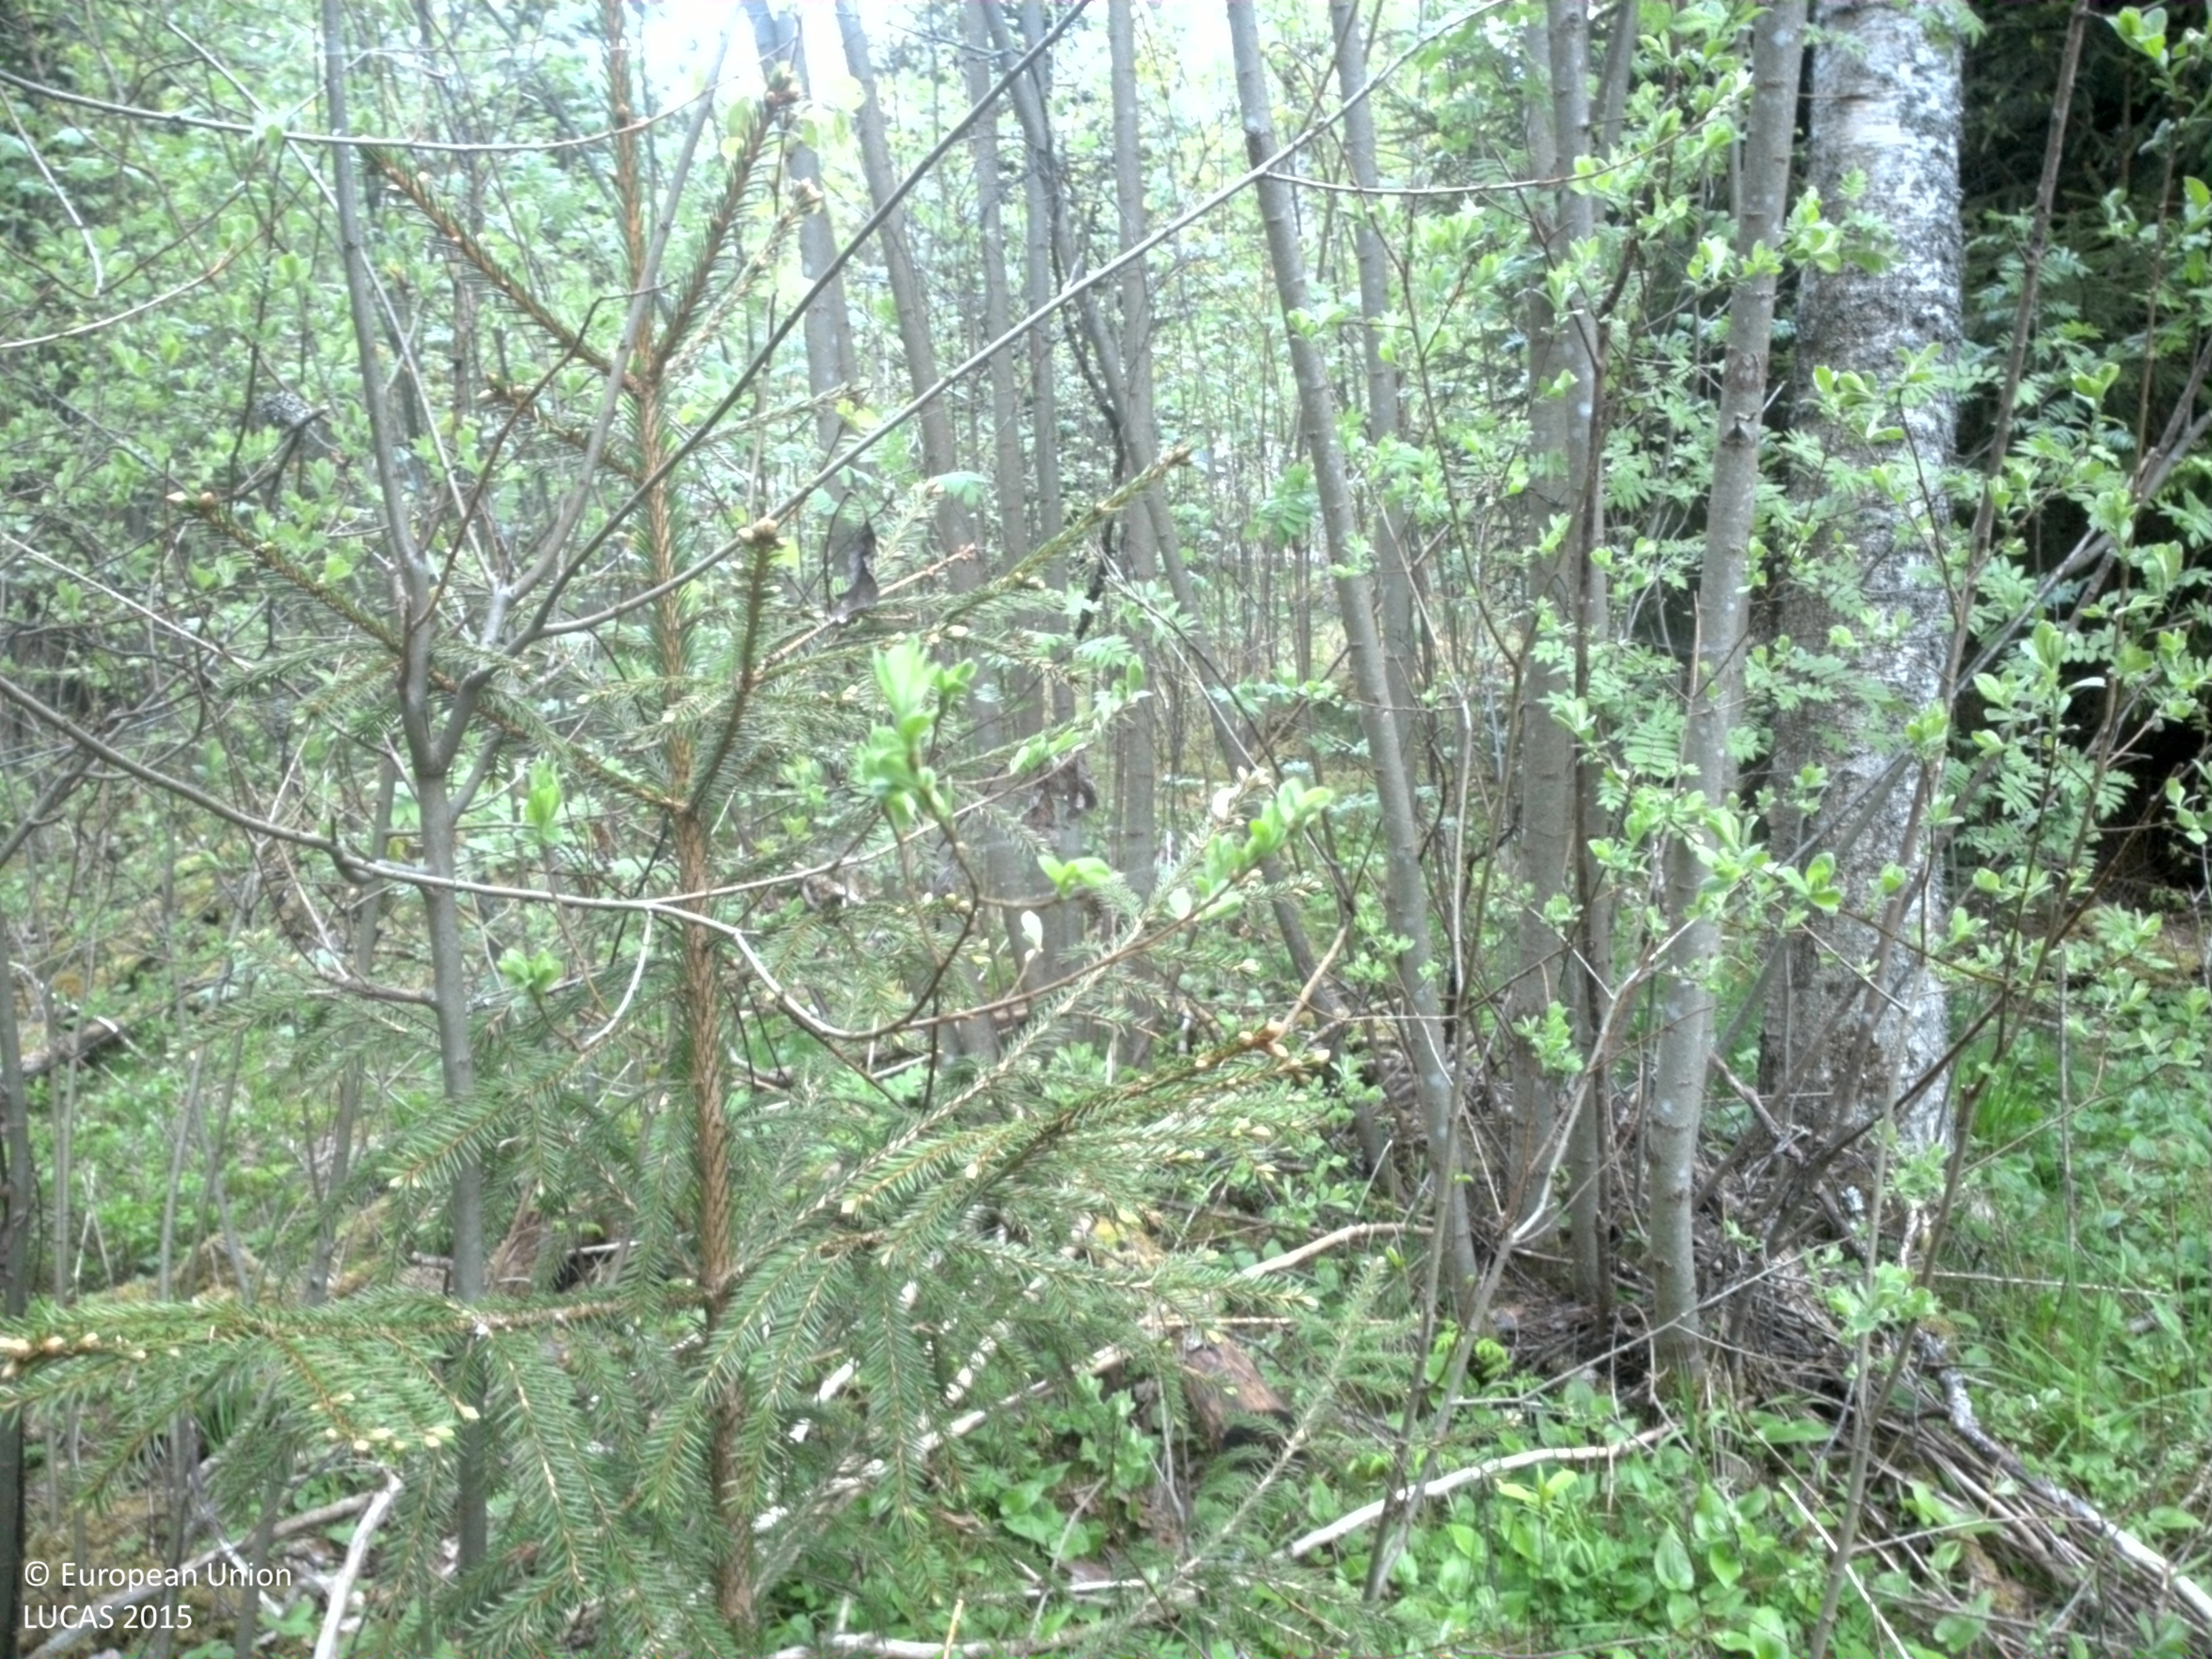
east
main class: Woodland
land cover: Broadleaved woodland
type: boreal forest
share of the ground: 50 - 75 %
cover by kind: broadleaved forest trees 65 %, shrubs 15 %, coniferous forest trees 10 %, herbaceous plants 10 %
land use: Forestry
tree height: > 5 m
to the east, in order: Broadleaved woodland; Paved roads, cycling and walking lanes; Broadleaved woodland; Dry stone walls; Broadleaved woodland; Grassland without tree/shrub cover; Broadleaved woodland; Dry stone walls; Broadleaved woodland; Dry stone walls; Spruce dominated mixed woodland
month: May
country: SE
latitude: 56.6397
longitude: 15.2322
